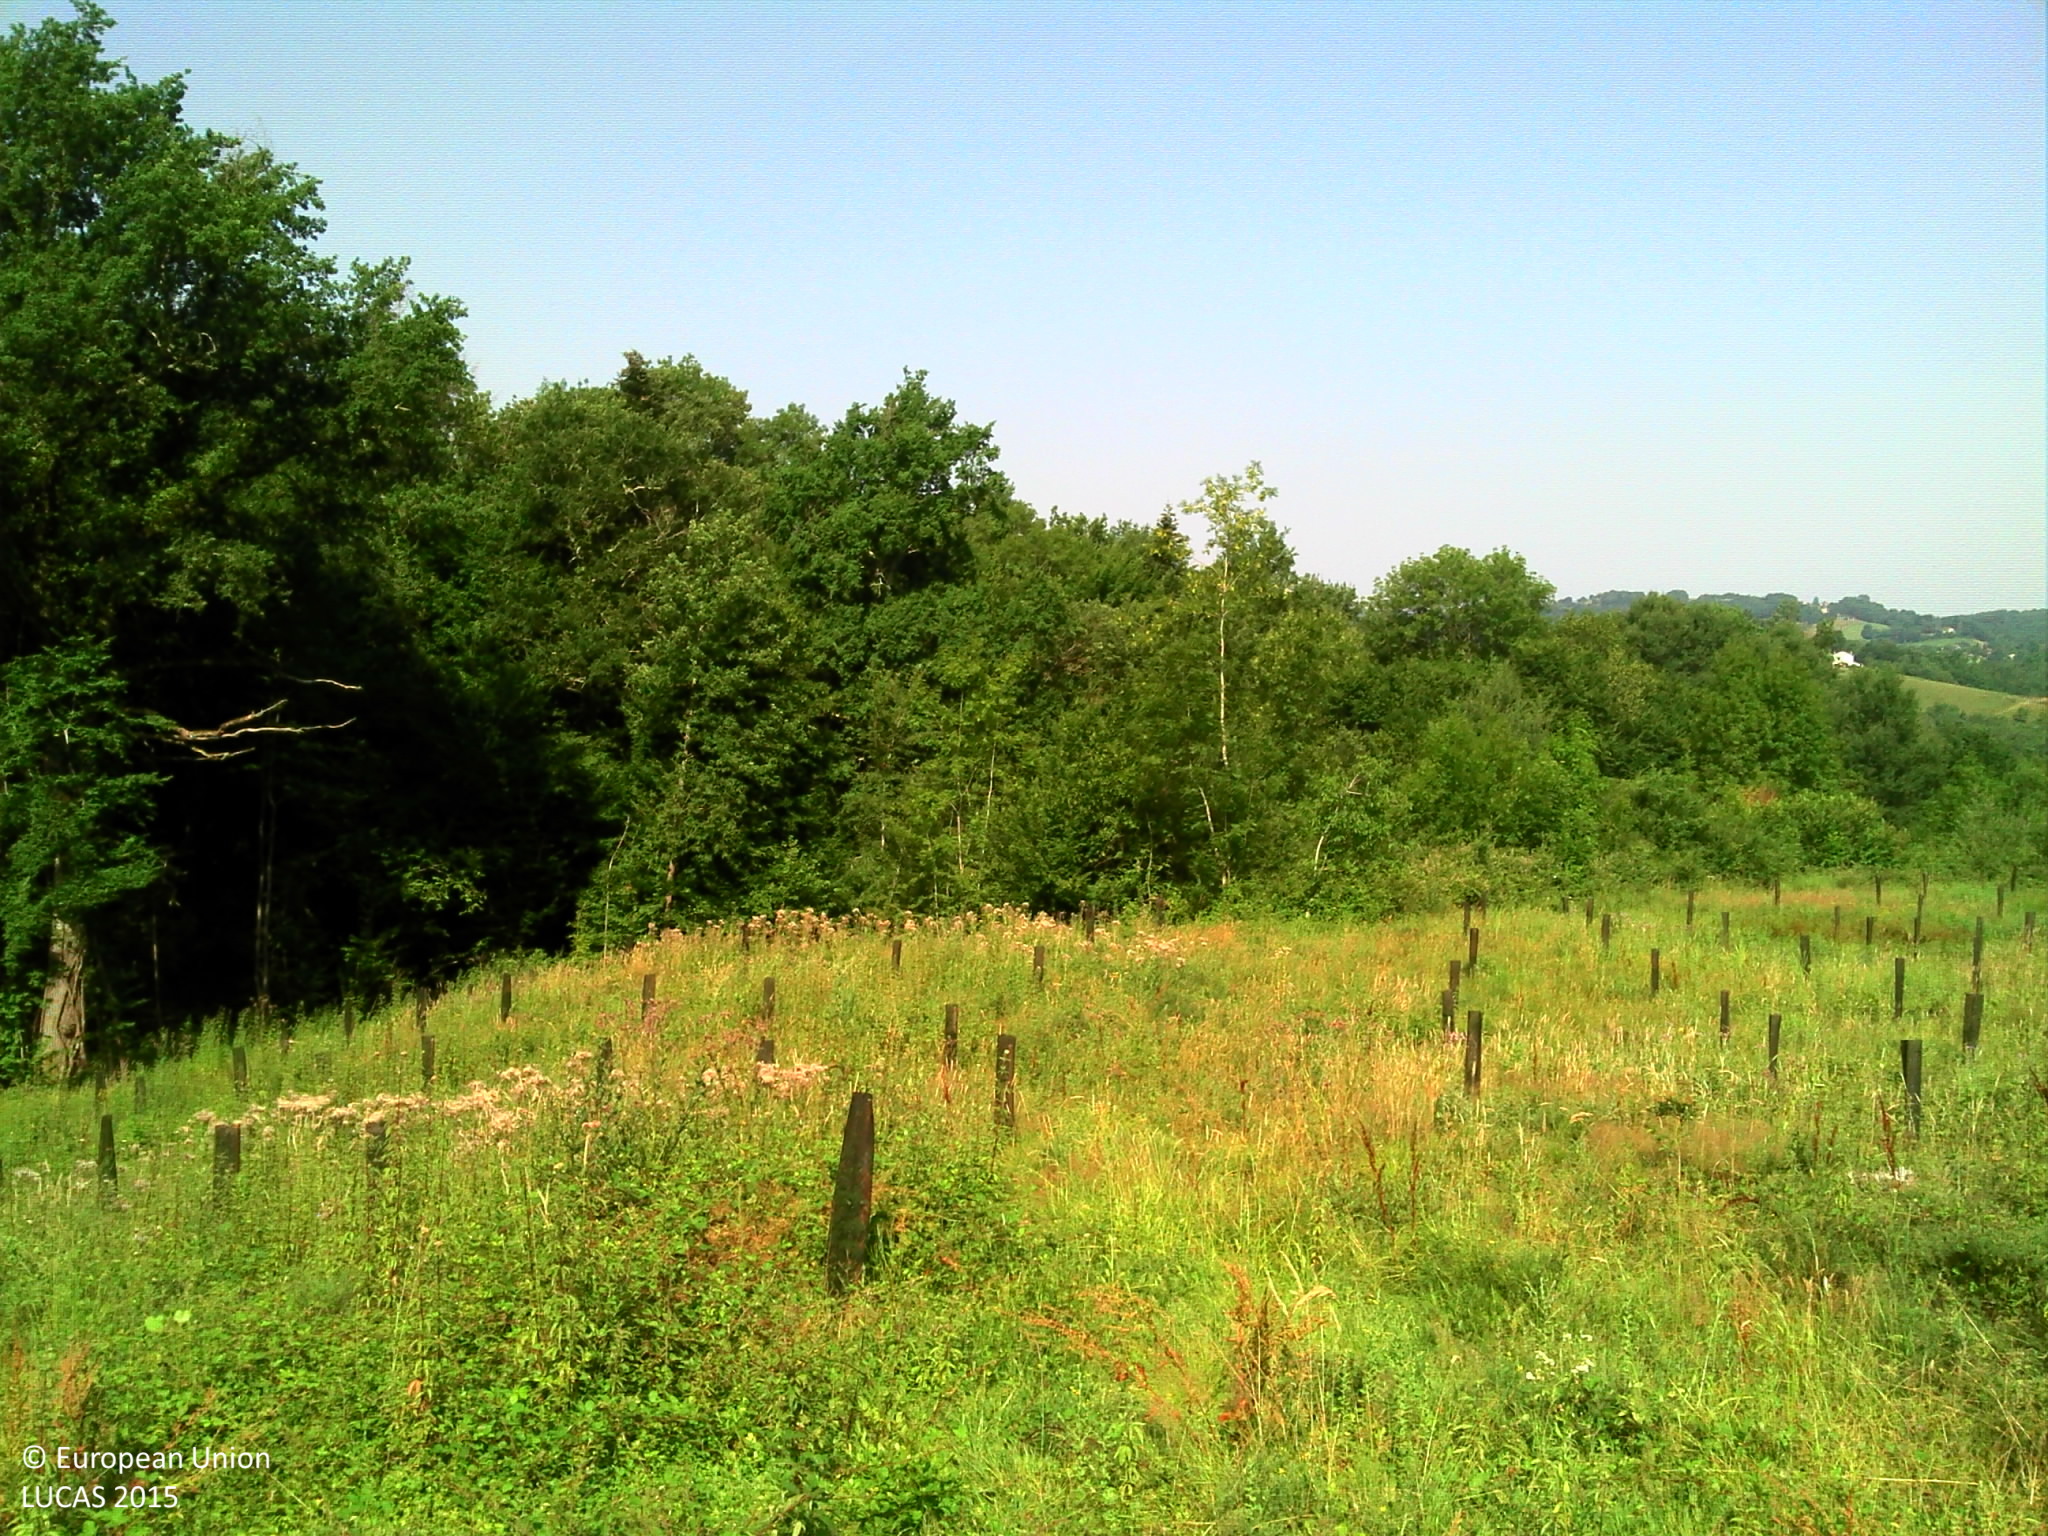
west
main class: Woodland
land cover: Broadleaved woodland
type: exotic forest
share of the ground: < 10 %
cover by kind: herbaceous plants 90 %, broadleaved forest trees 10 %
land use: Forestry
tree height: < 5 m
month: July
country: FR
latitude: 43.1048
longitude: 1.1941
